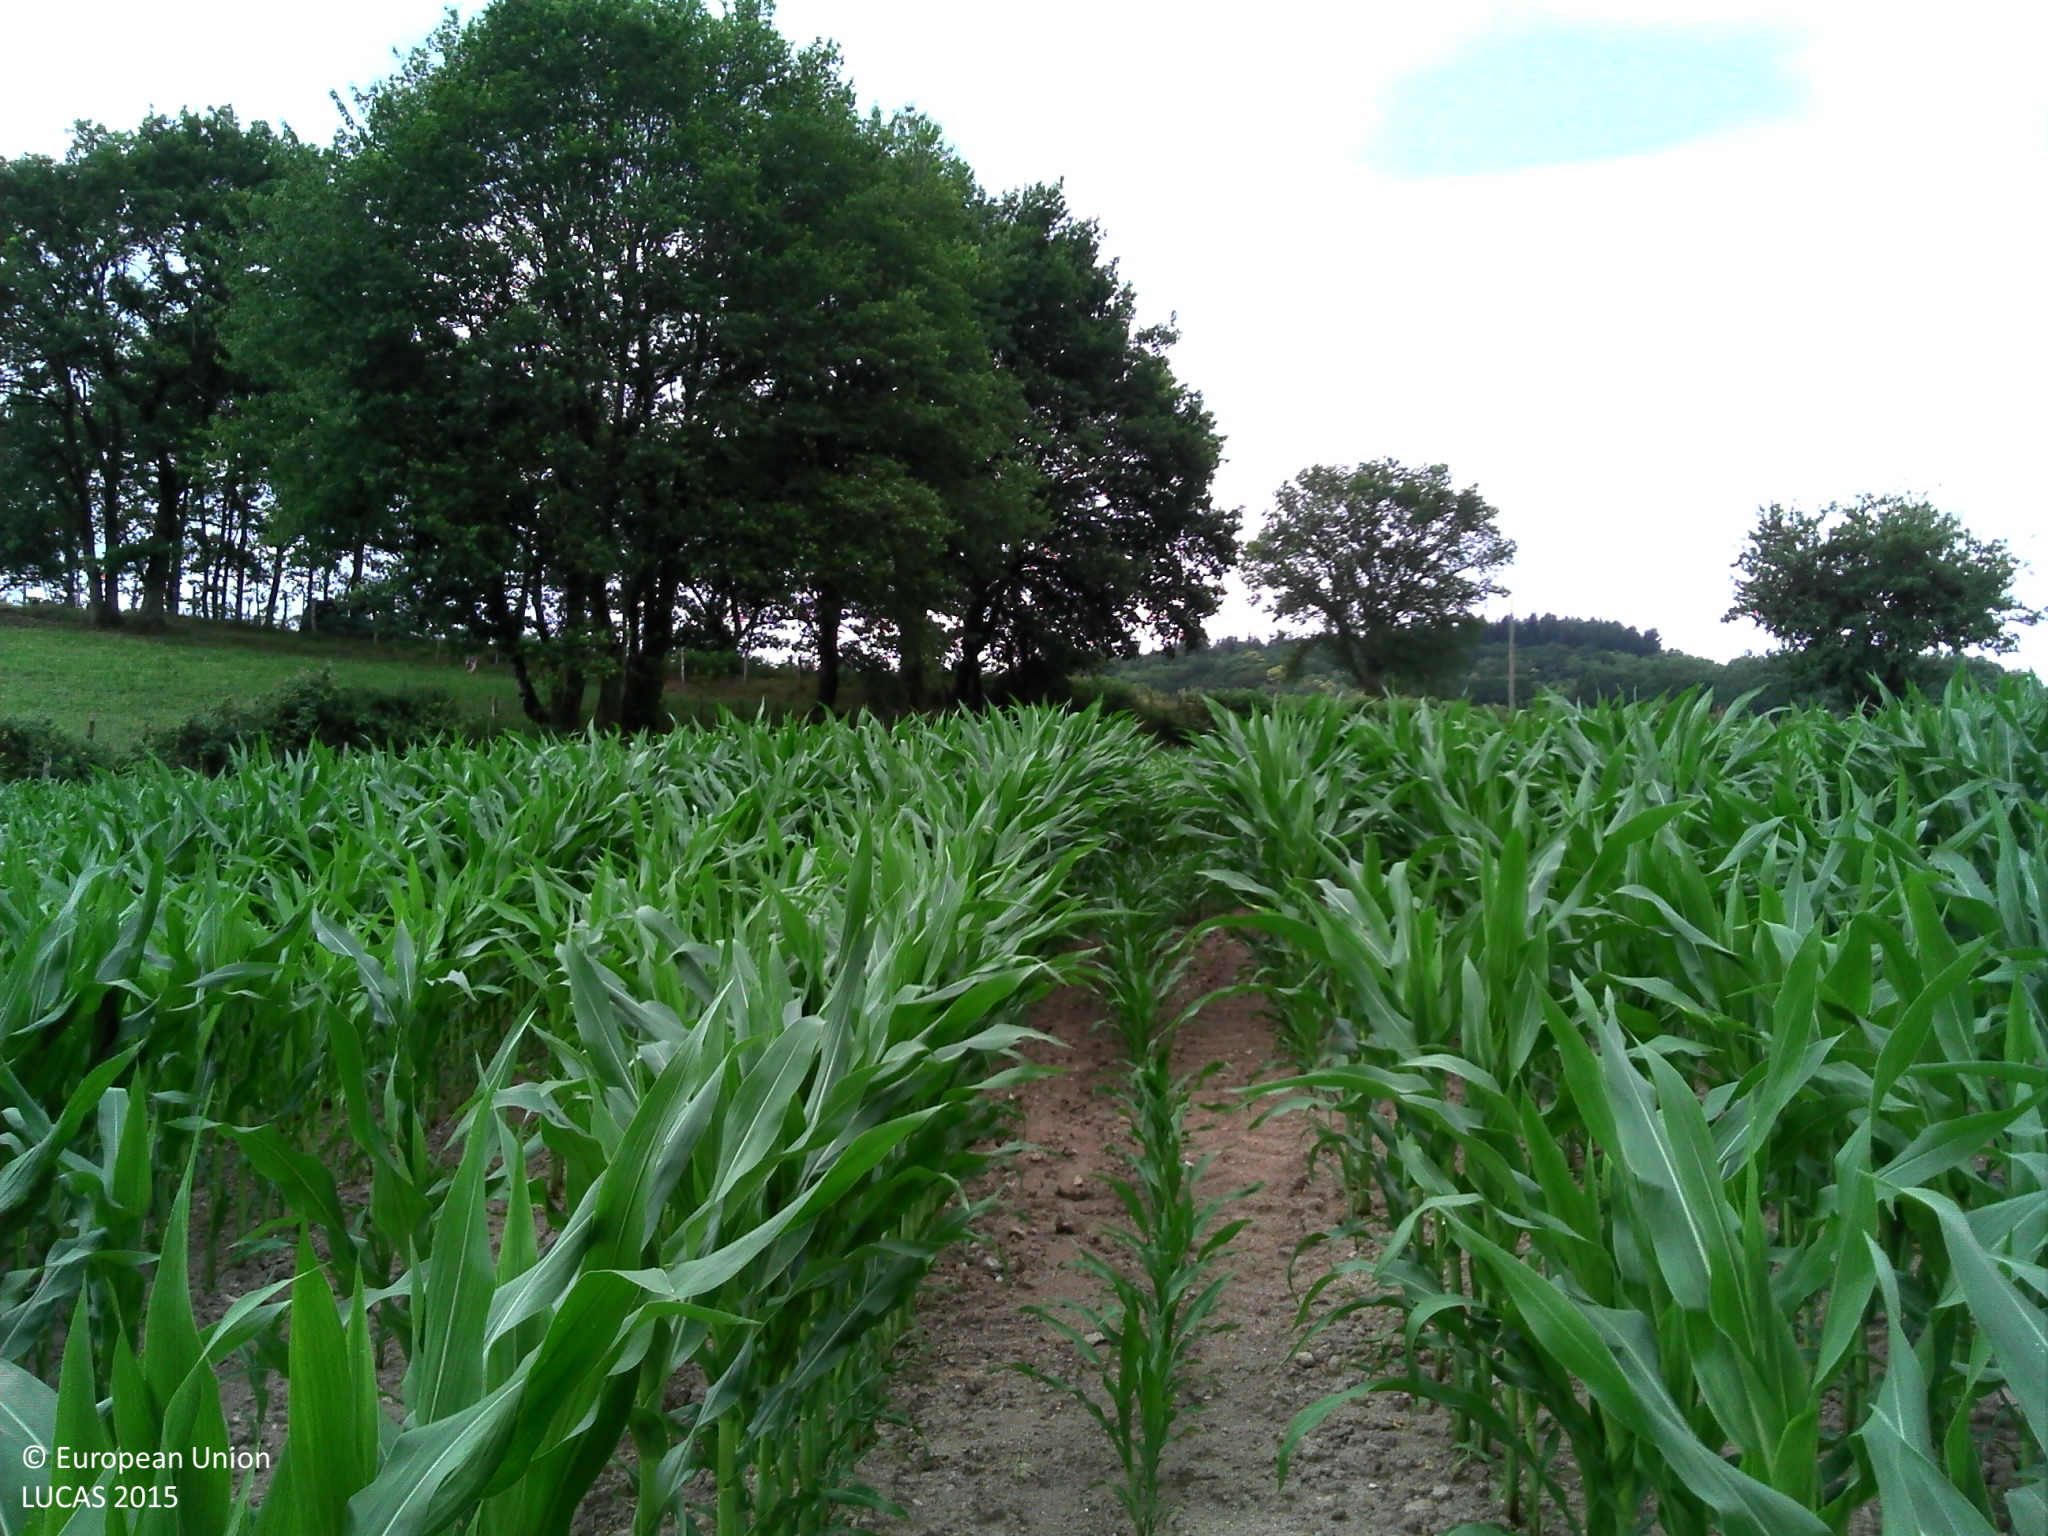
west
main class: Cropland
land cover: Maize
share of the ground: > 75 %
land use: Agriculture (excluding fallow land and kitchen gardens)
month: July
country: FR
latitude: 45.7627
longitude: 1.7781
